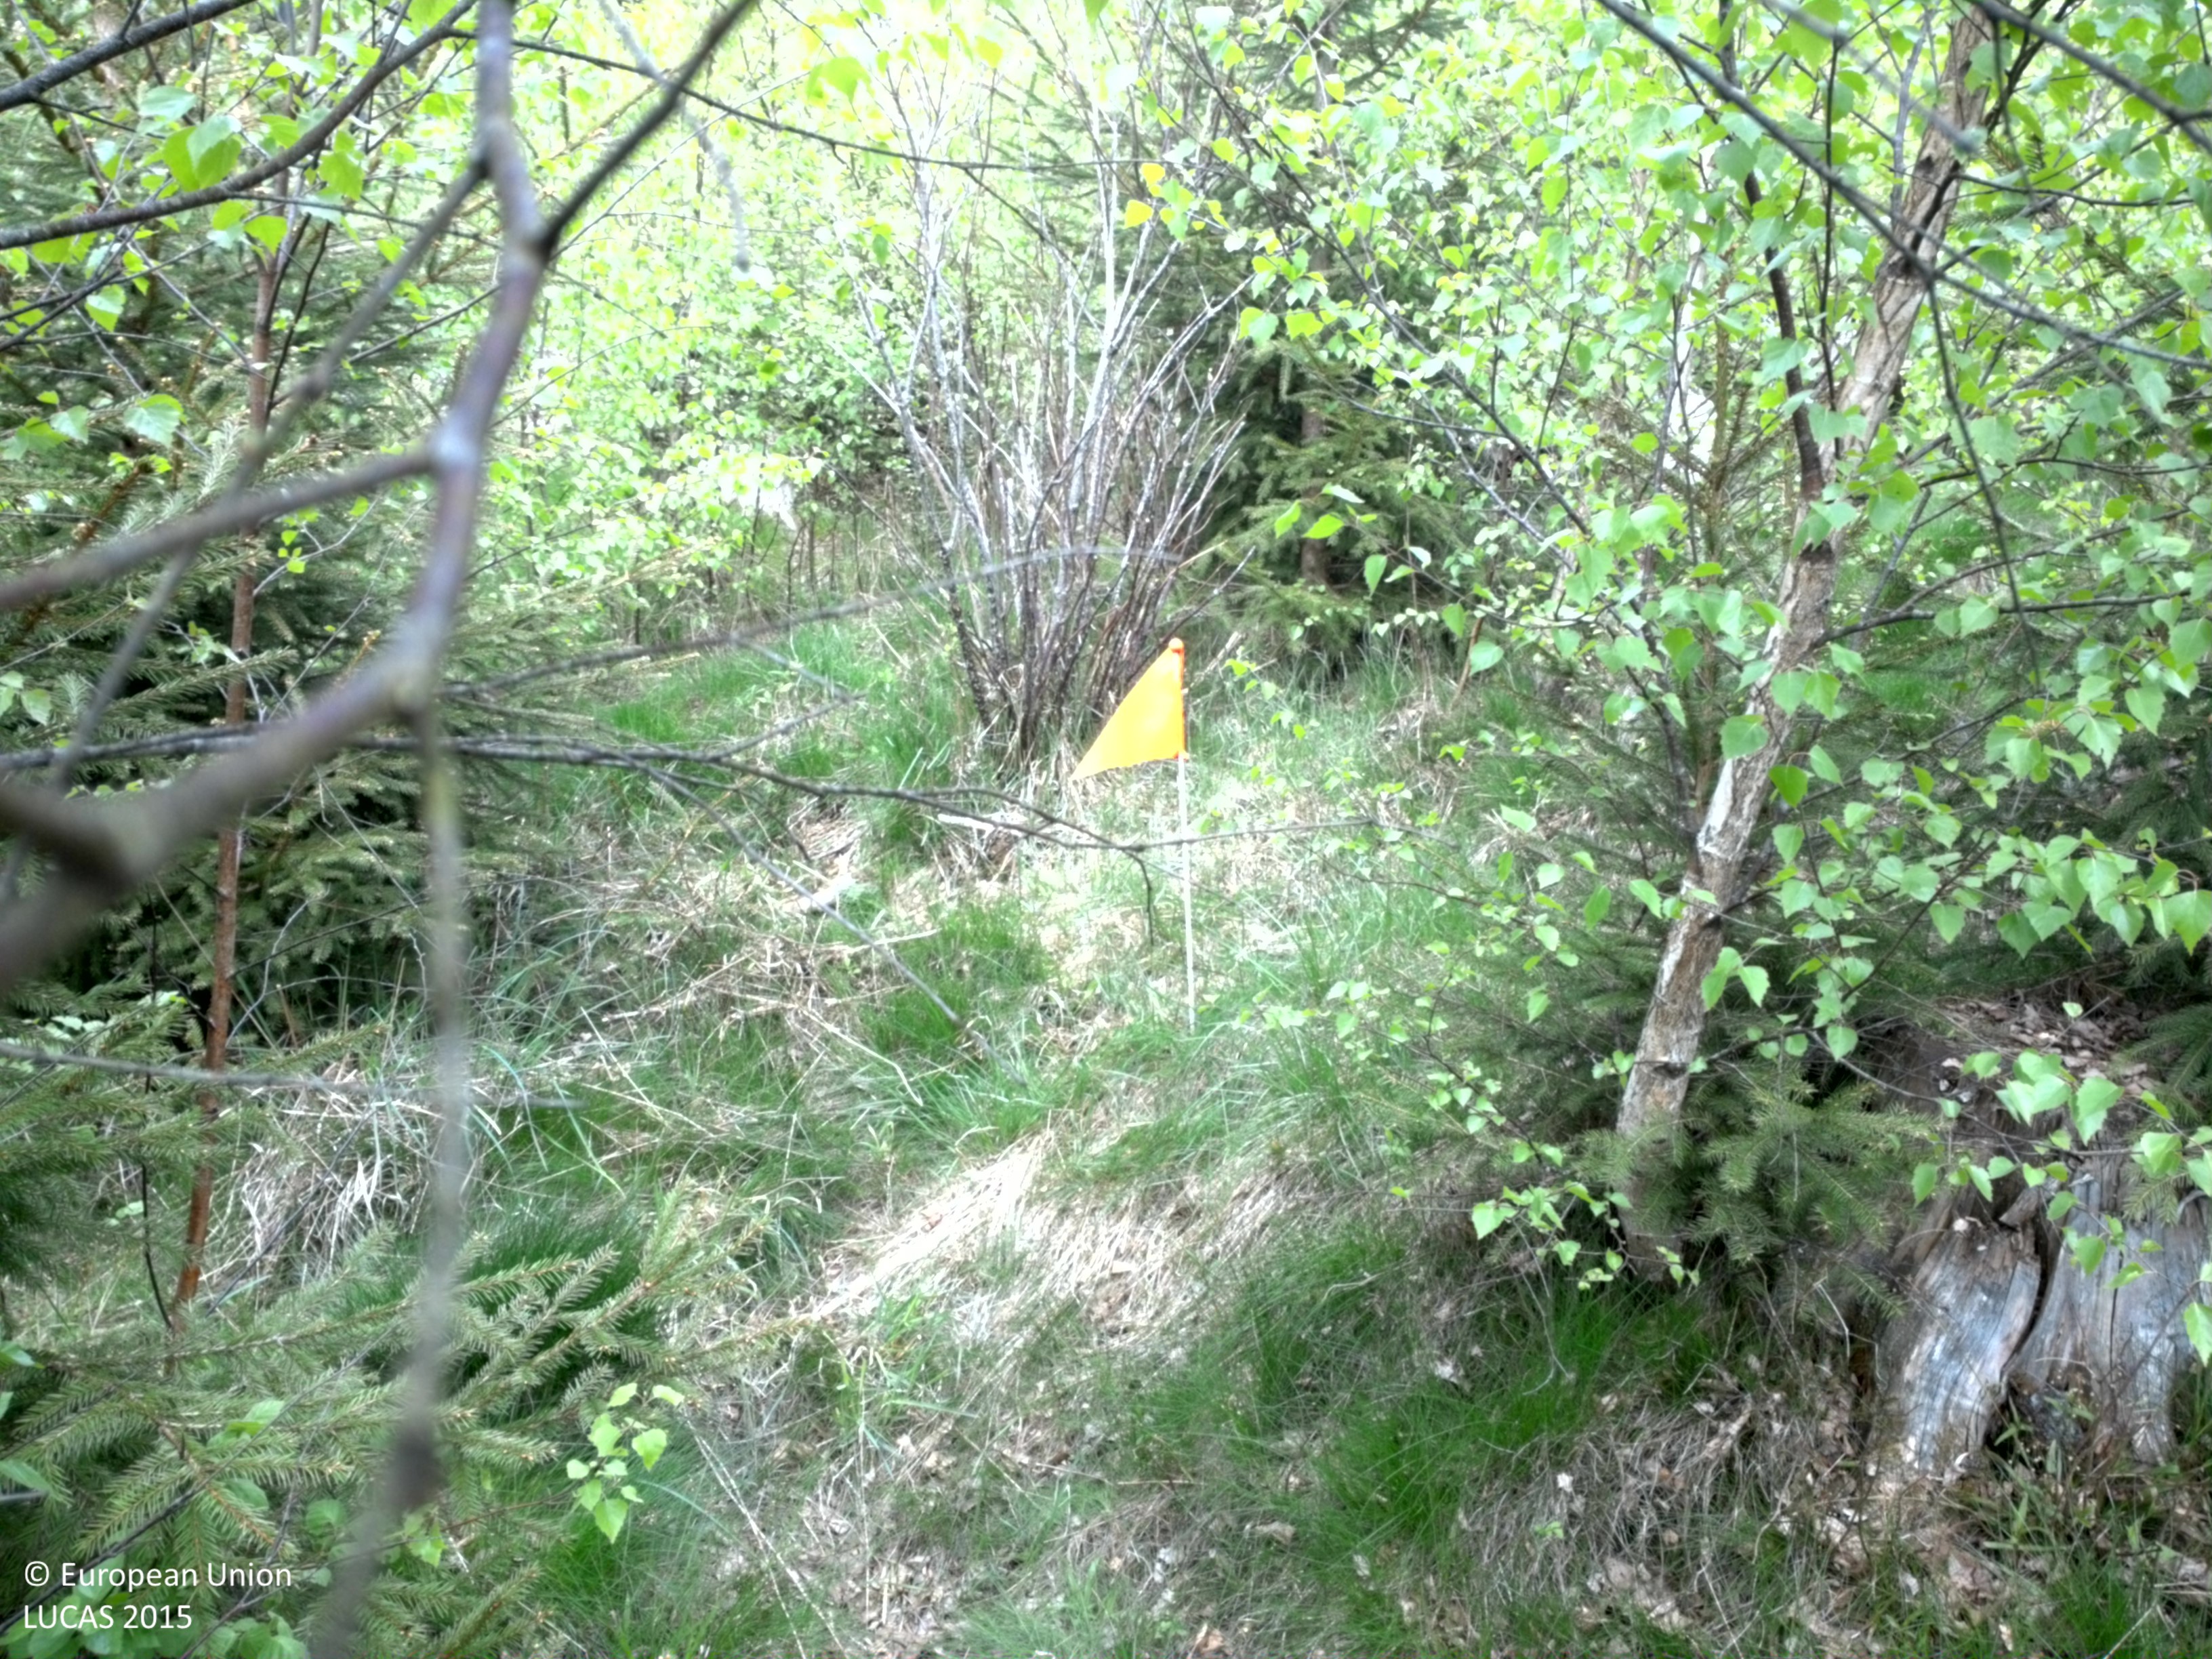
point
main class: Woodland
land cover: Broadleaved woodland
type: boreal forest
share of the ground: > 75 %
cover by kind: broadleaved forest trees 85 %, herbaceous plants 10 %, coniferous forest trees 5 %
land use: Forestry
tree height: < 5 m
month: May
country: SE
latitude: 56.7392
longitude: 15.4424
